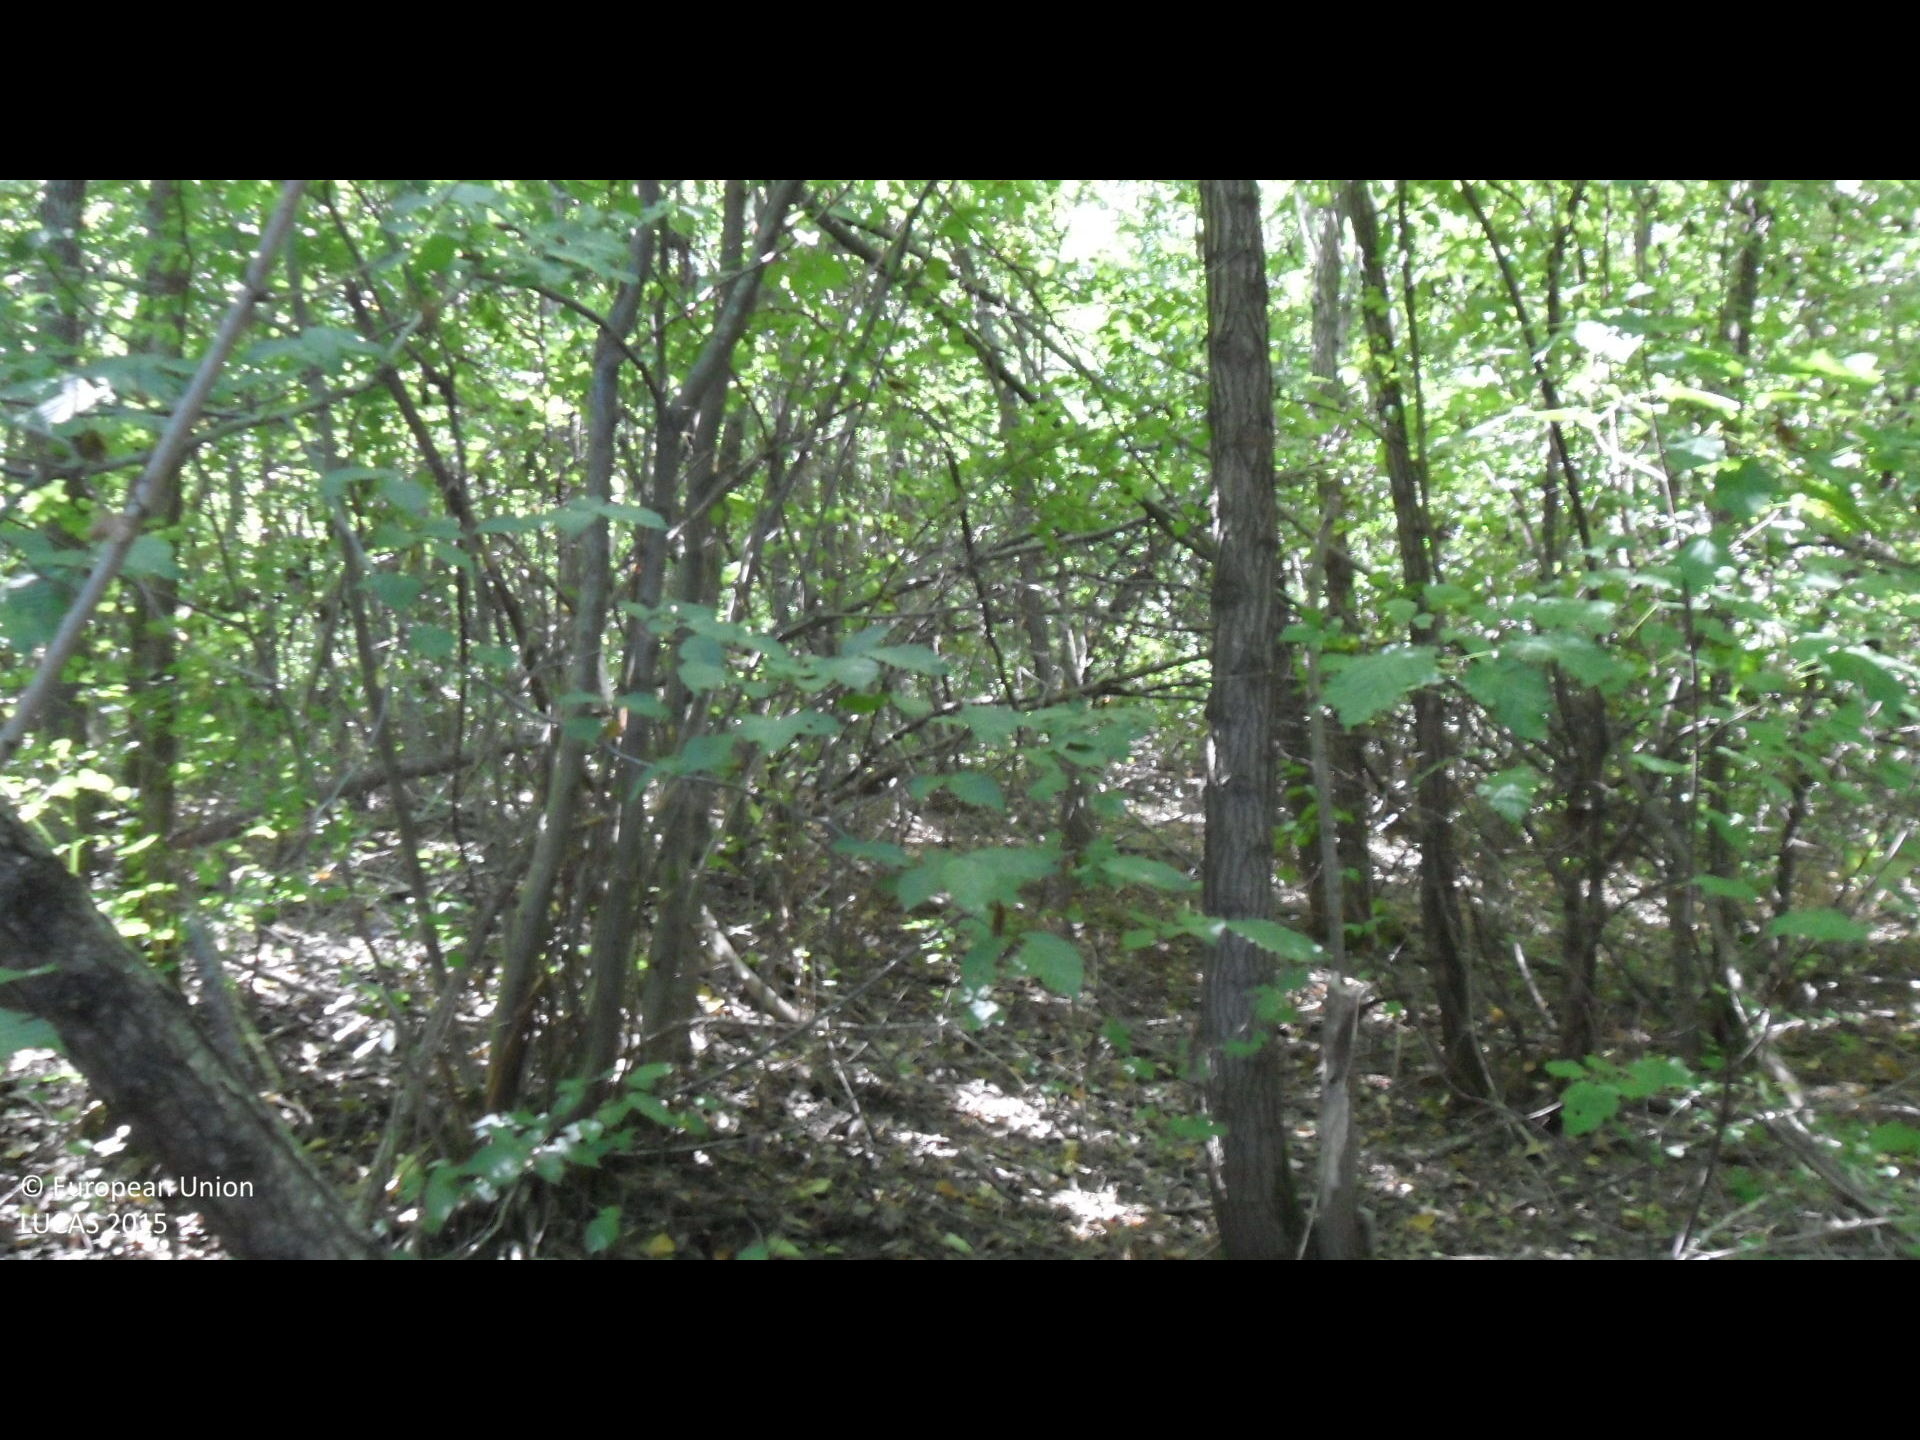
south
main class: Woodland
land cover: Broadleaved woodland
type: beech forest
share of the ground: > 75 %
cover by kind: broadleaved forest trees 95 %, unconsolidated bare surface 5 %
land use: Forestry
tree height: > 5 m
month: September
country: BG
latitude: 43.1508
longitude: 26.3659
